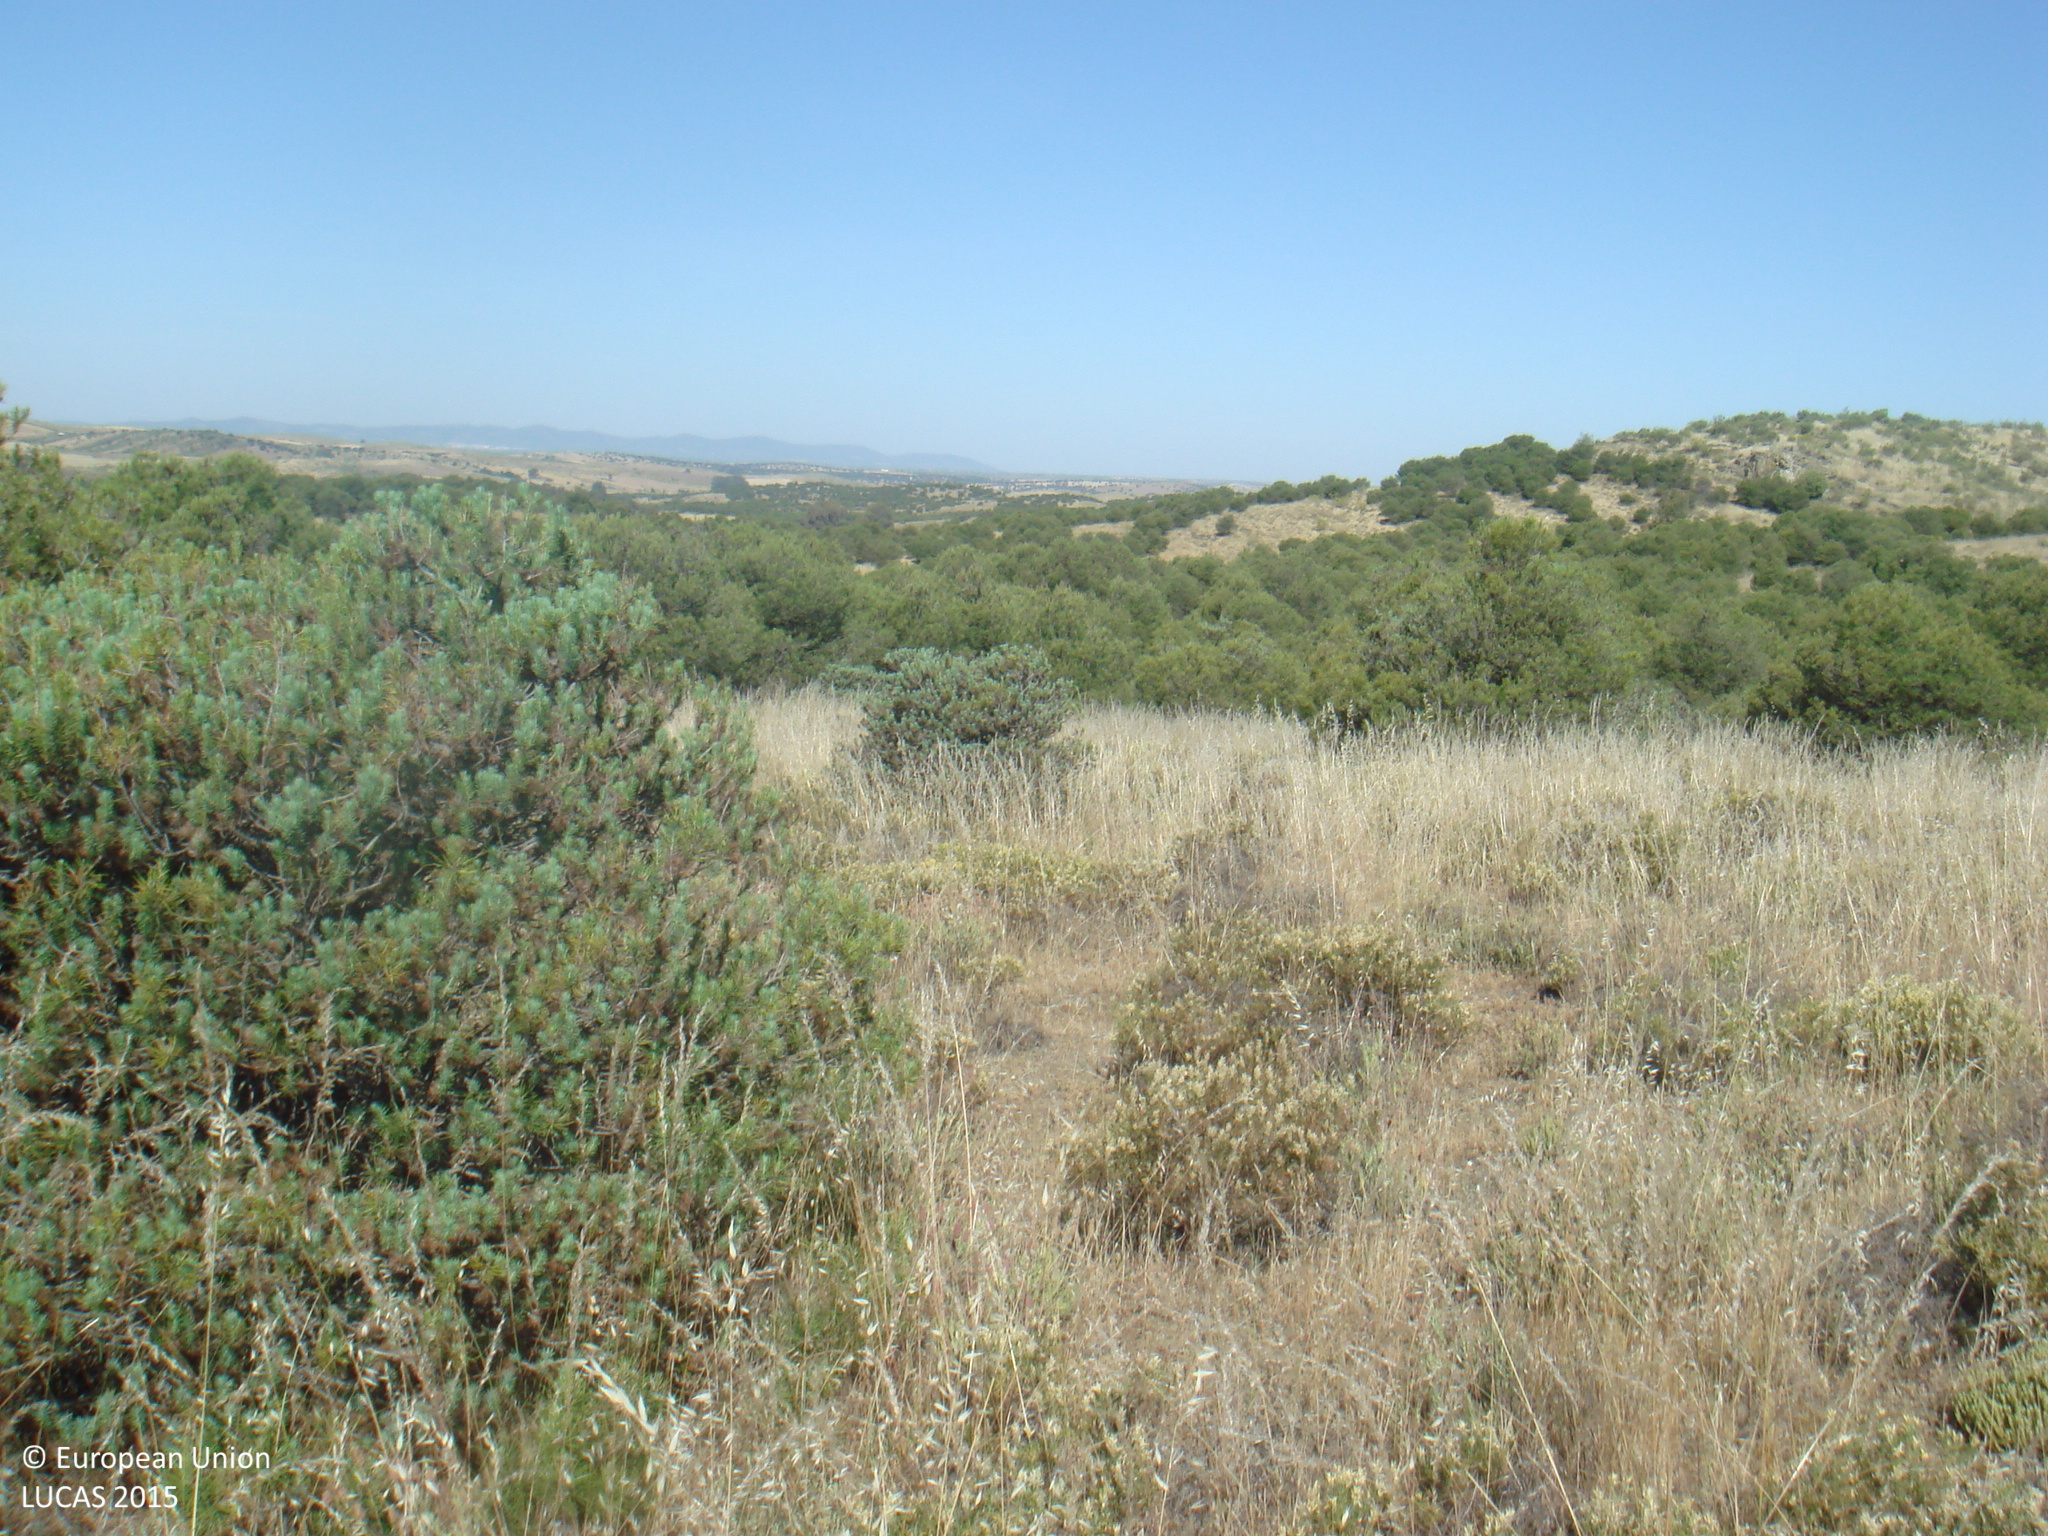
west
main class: Woodland
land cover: Pine dominated coniferous woodland
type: coniferous forest of the mediterranean region
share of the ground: 10 - 25 %
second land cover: Shrubland without tree cover
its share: 10 - 25 %
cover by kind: herbaceous plants 65 %, coniferous forest trees 25 %, shrubs 10 %
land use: Forestry
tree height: < 5 m
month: May
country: ES
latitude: 38.6045
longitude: -5.1548
